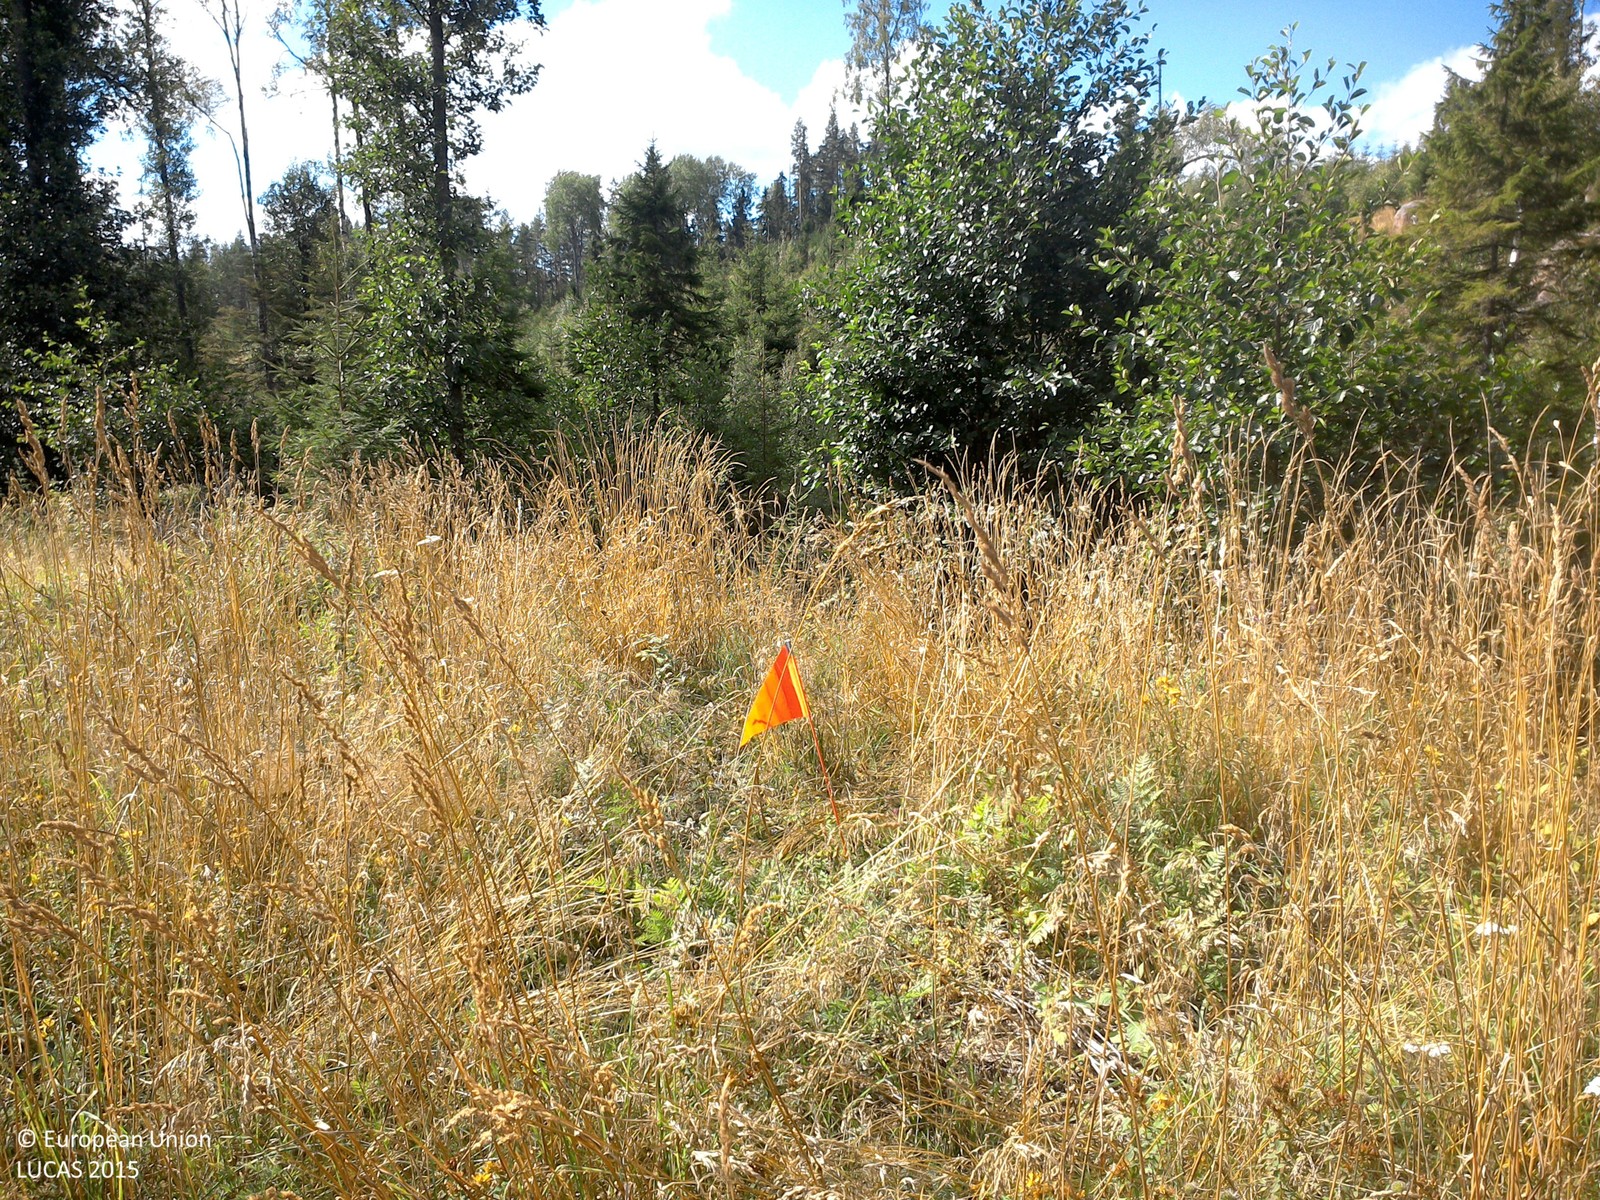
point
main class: Grassland
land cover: Grassland without tree/shrub cover
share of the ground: > 75 %
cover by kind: herbaceous plants 100 %
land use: Semi-natural and natural areas not in use
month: August
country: SE
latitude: 58.0762
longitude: 15.3700
